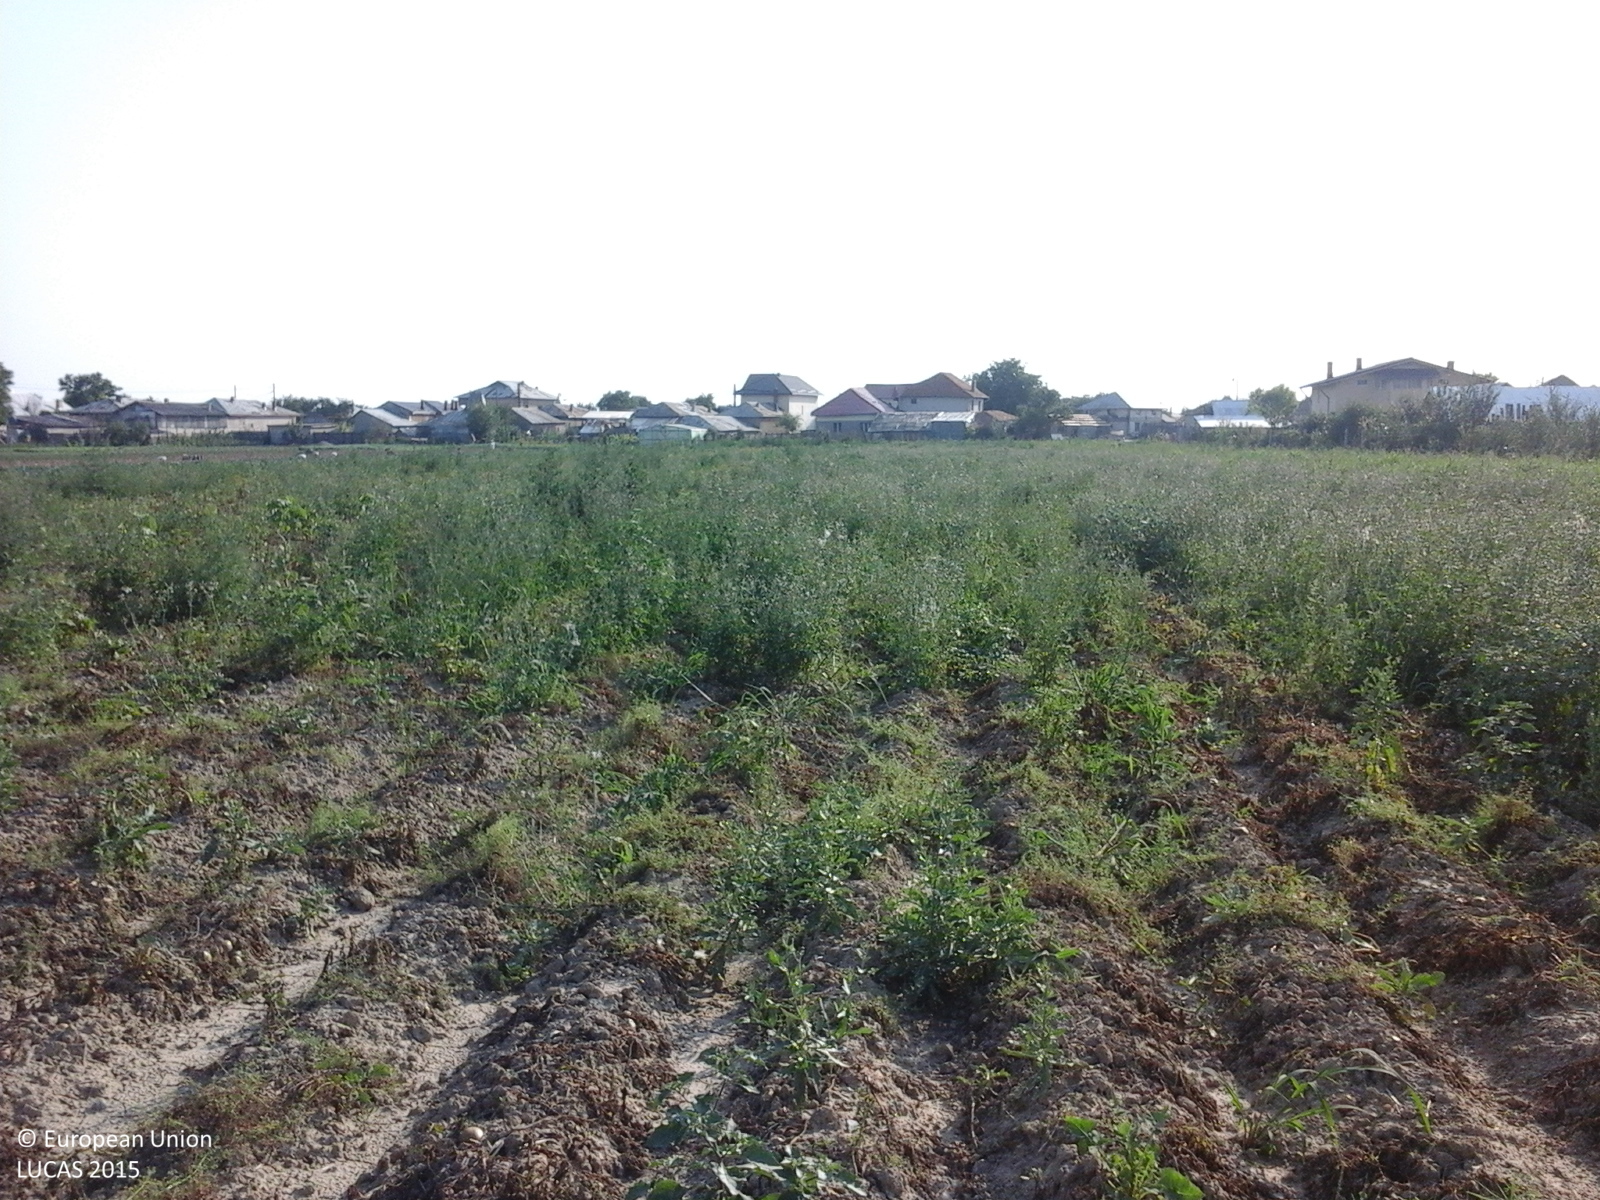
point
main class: Cropland
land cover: Potatoes
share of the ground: 50 - 75 %
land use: Agriculture (excluding fallow land and kitchen gardens)
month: July
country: RO
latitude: 44.6201
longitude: 25.6611
